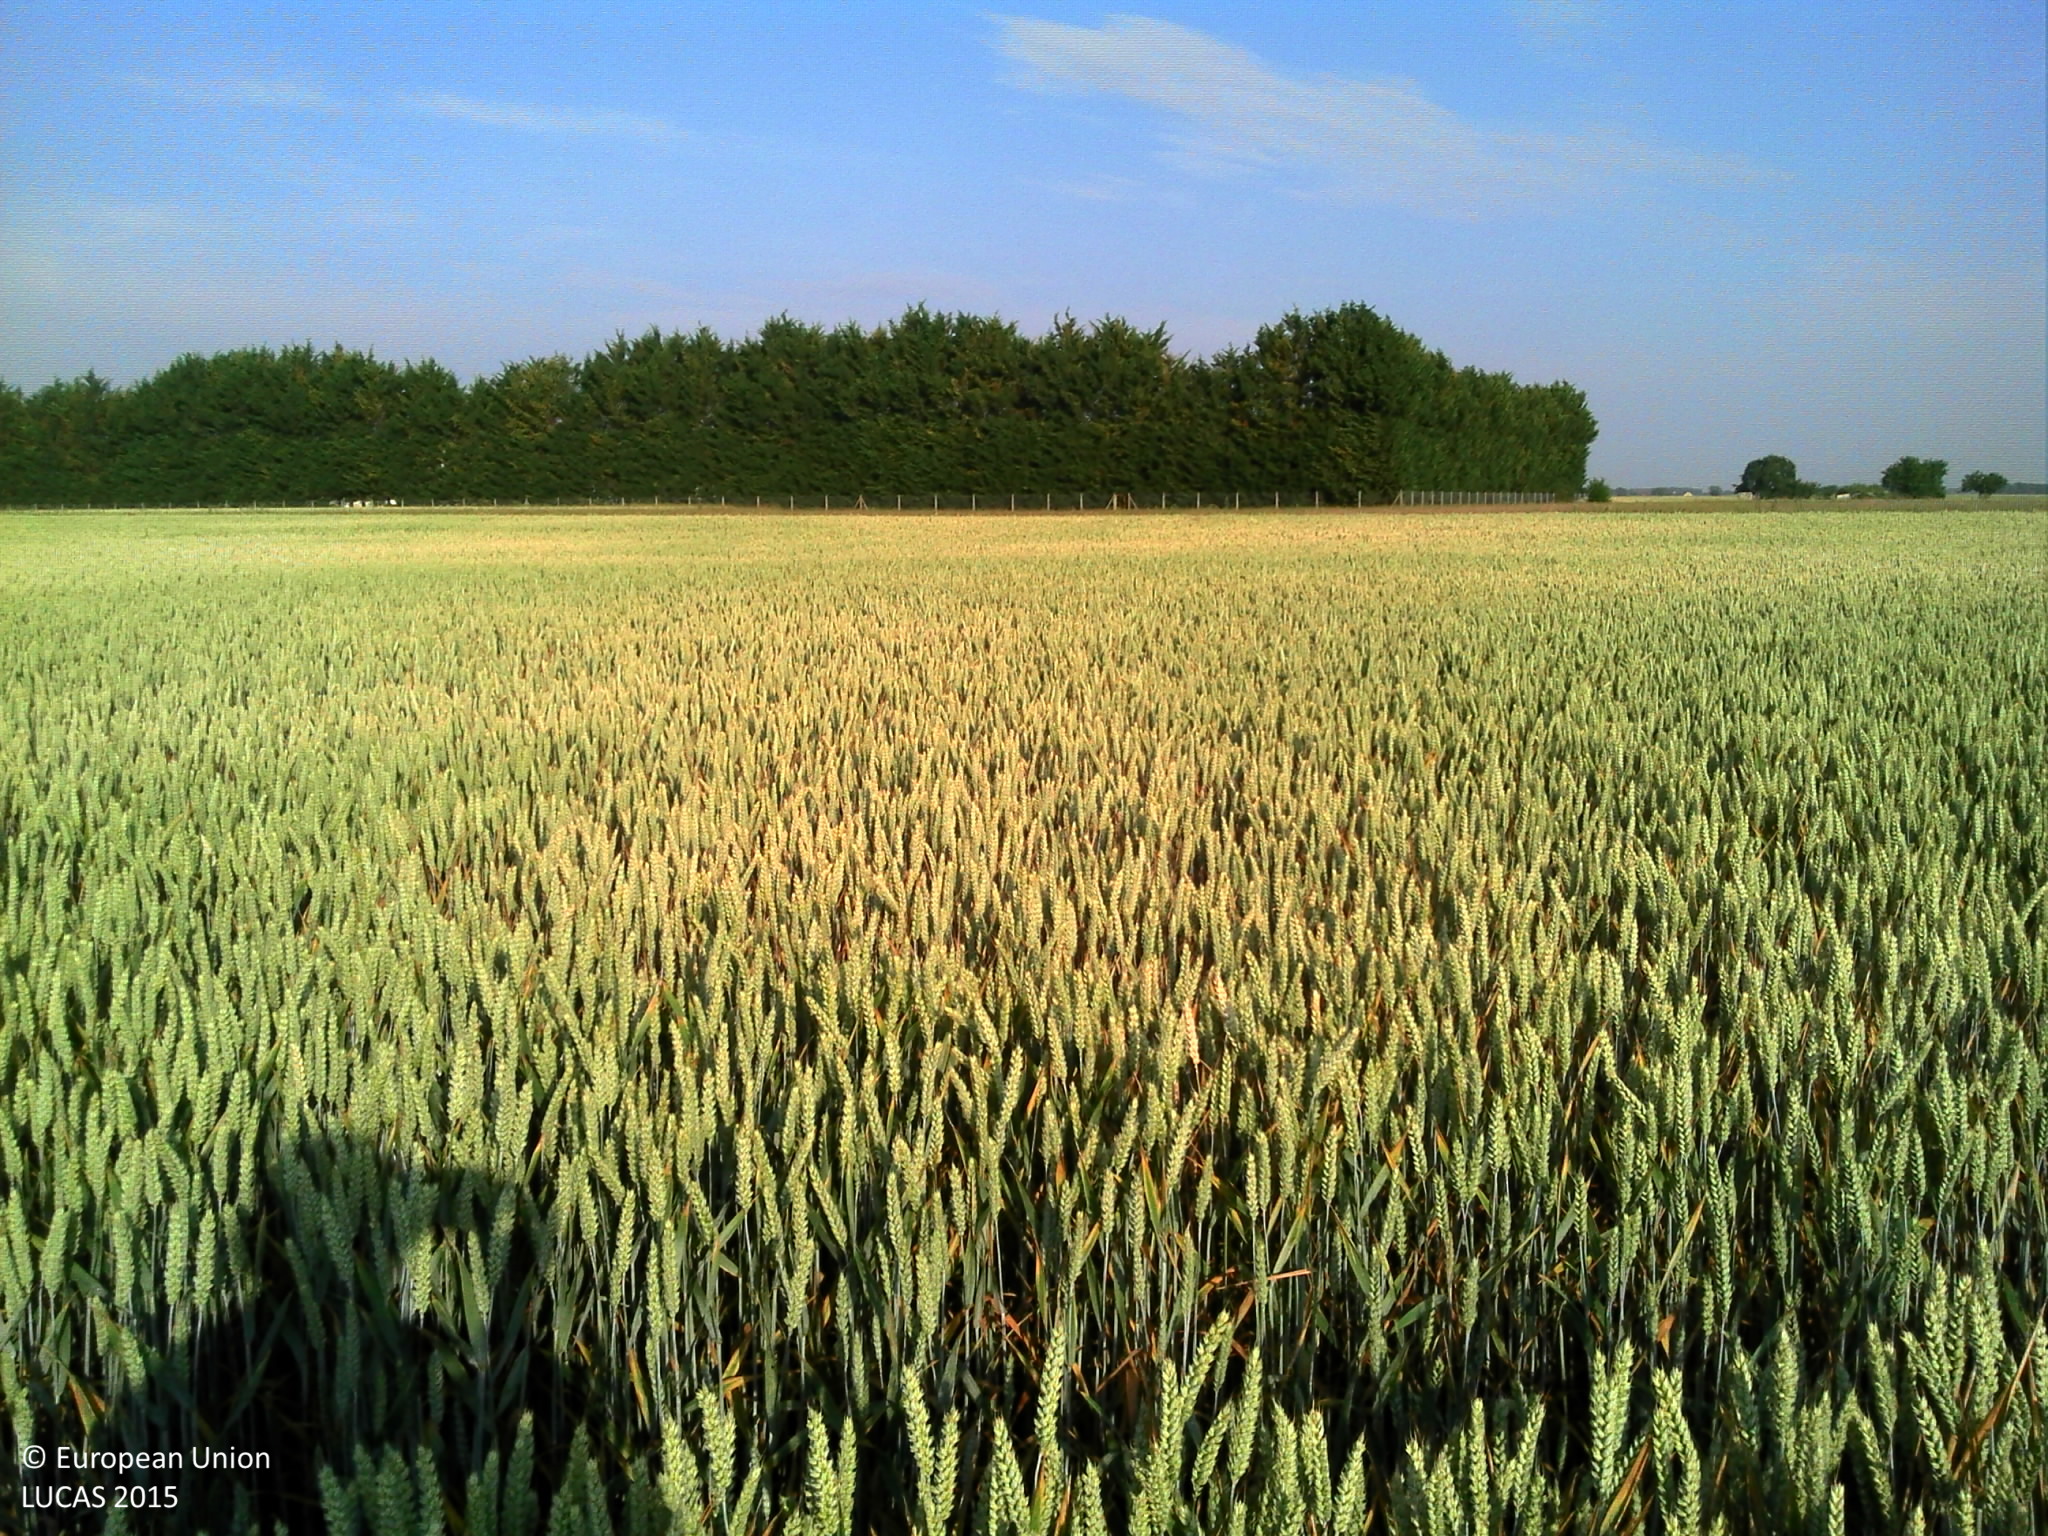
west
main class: Cropland
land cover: Common wheat
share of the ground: > 75 %
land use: Agriculture (excluding fallow land and kitchen gardens)
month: June
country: FR
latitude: 46.5642
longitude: 0.5244
